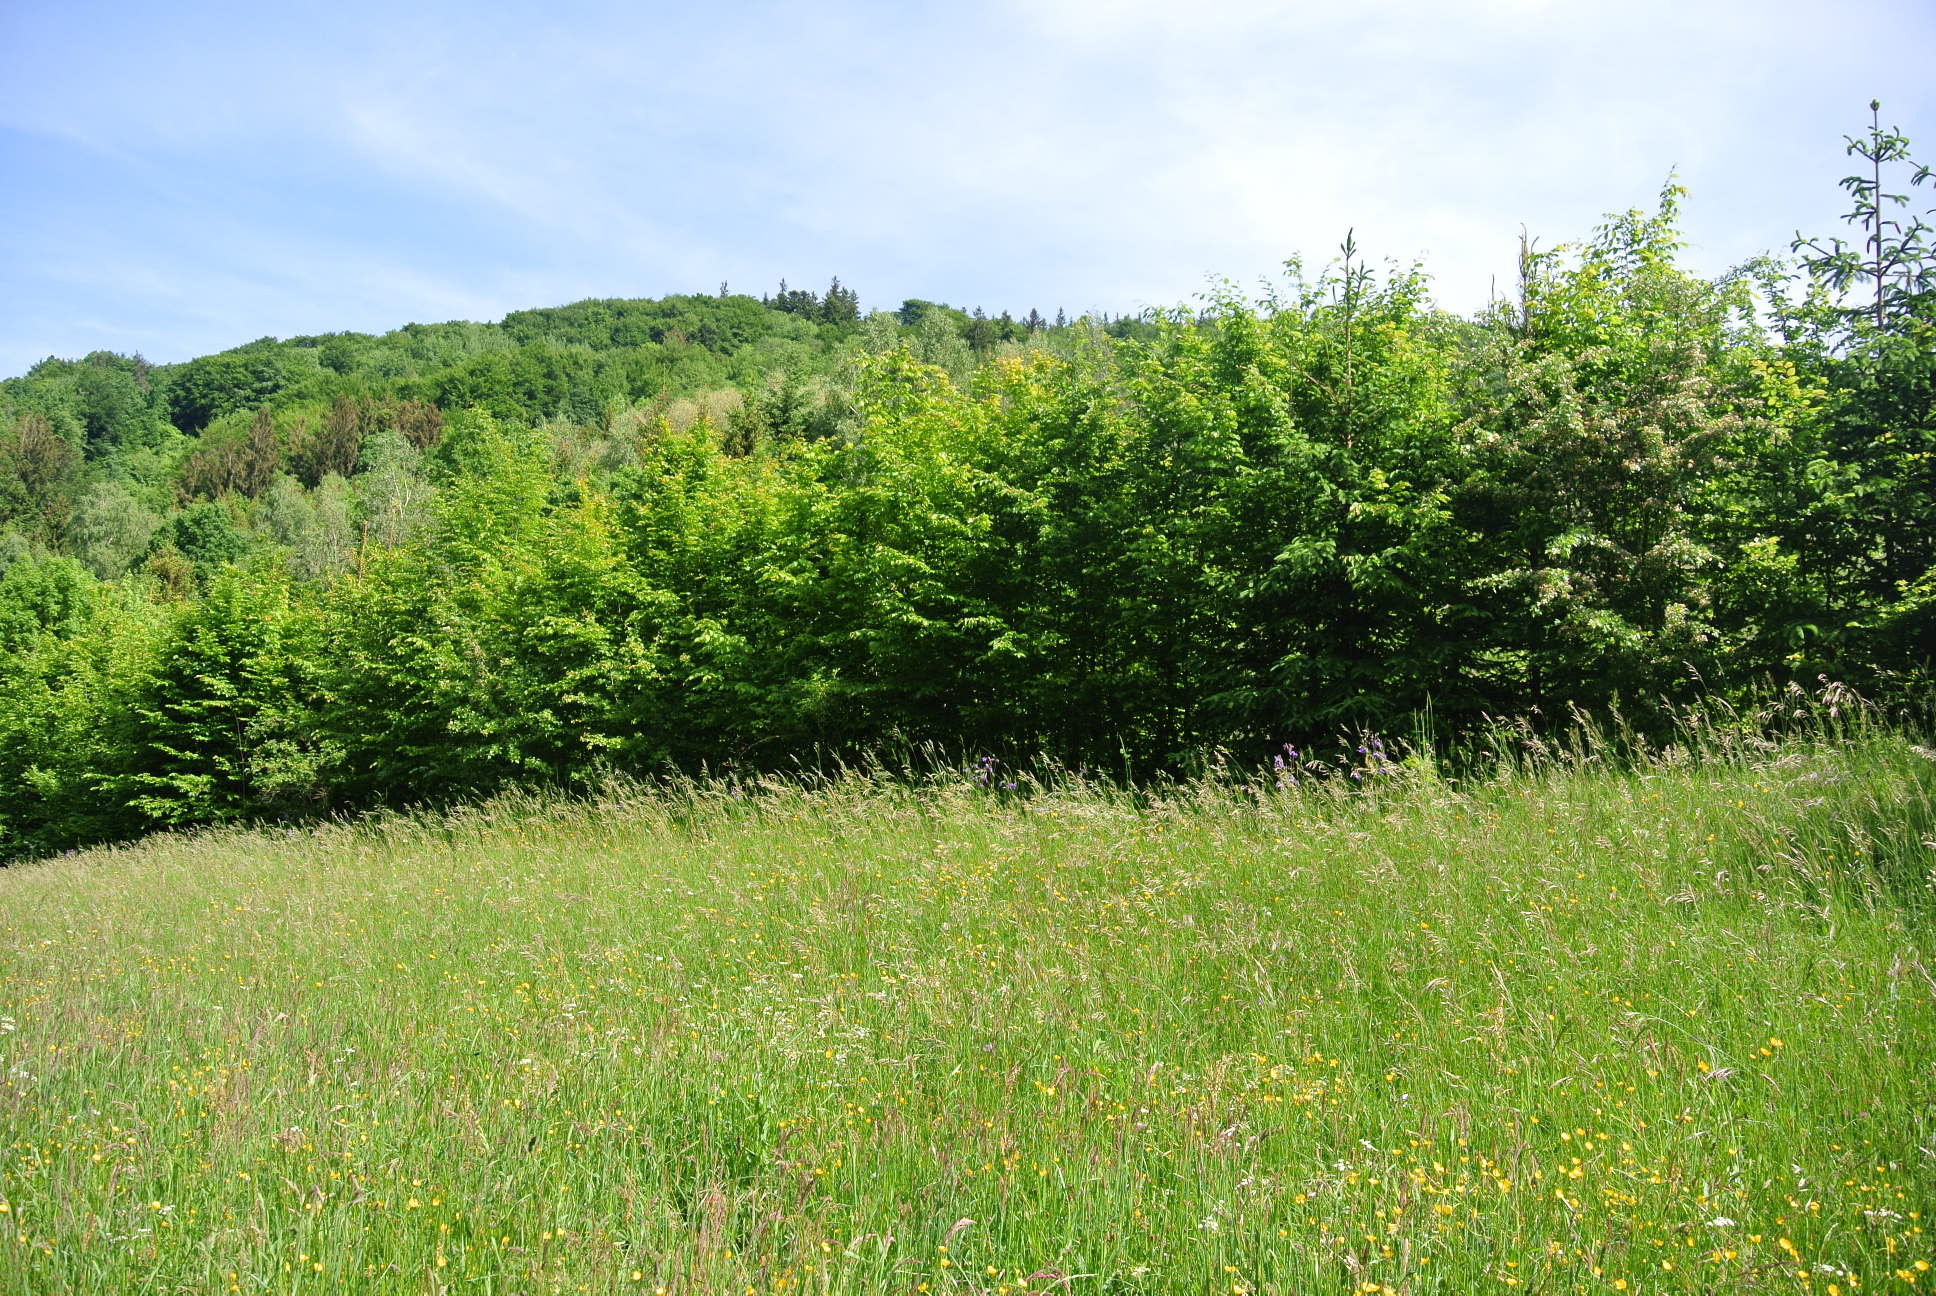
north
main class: Grassland
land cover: Grassland without tree/shrub cover
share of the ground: > 75 %
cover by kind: herbaceous plants 100 %
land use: Agriculture (excluding fallow land and kitchen gardens)
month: May
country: AT
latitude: 48.0328
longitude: 15.8367
